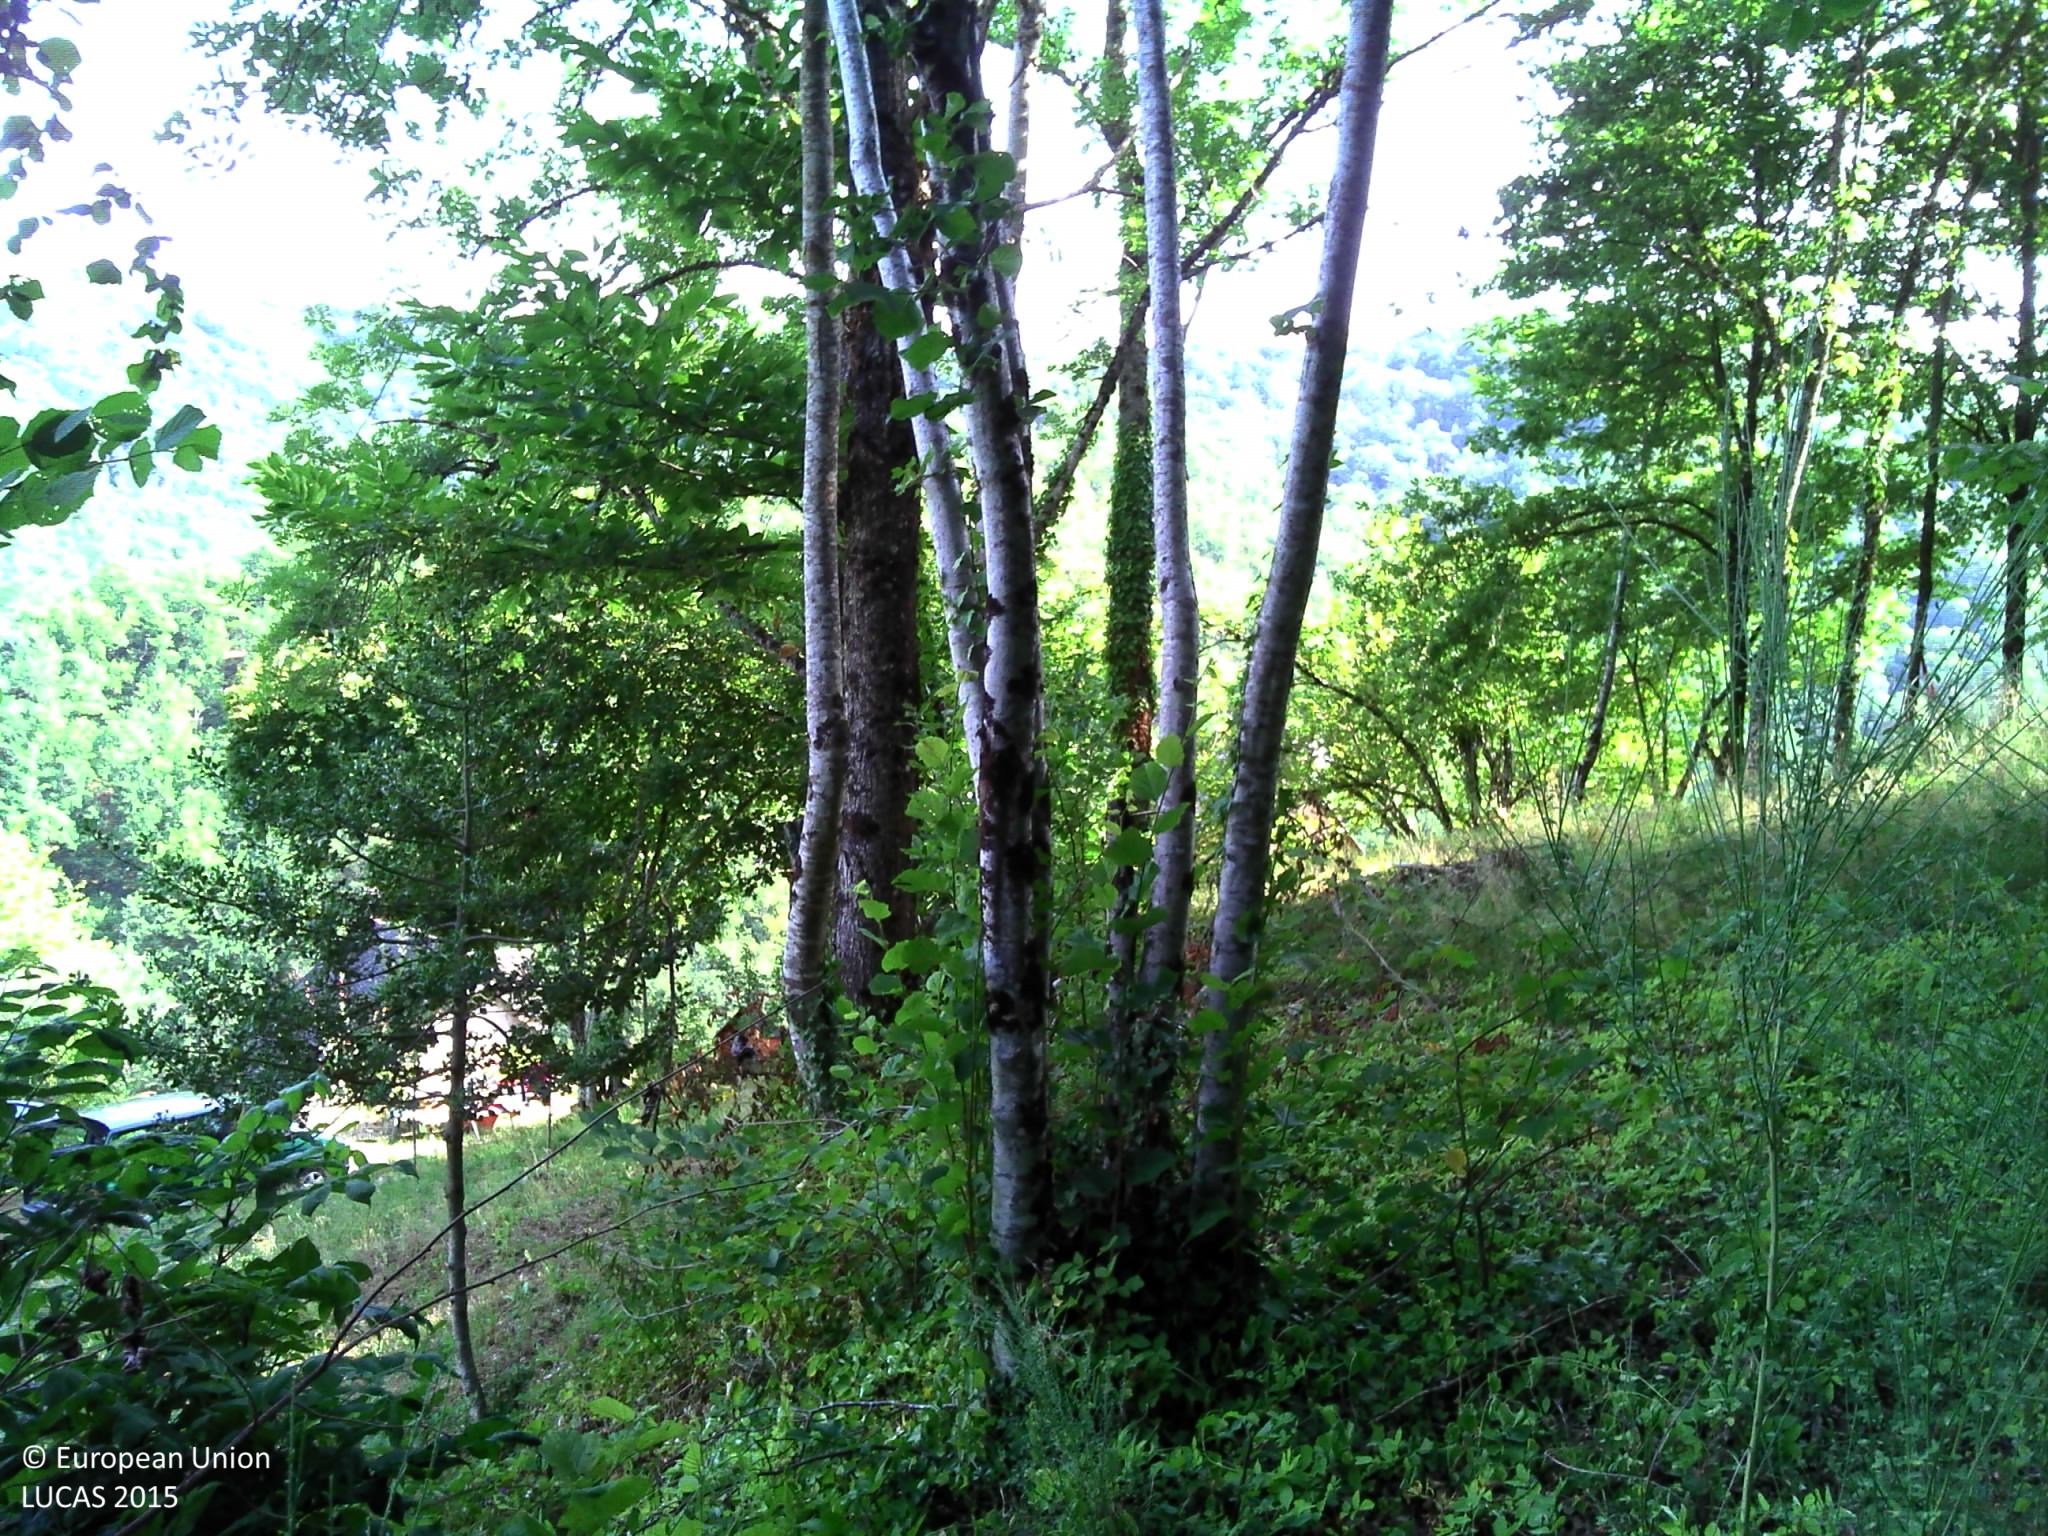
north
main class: Woodland
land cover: Broadleaved woodland
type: acidophilous oak and oak-birch forest
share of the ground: > 75 %
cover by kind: broadleaved forest trees 75 %, shrubs 20 %, herbaceous plants 5 %
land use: Forestry
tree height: > 5 m
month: July
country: FR
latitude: 44.4940
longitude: 2.9994
